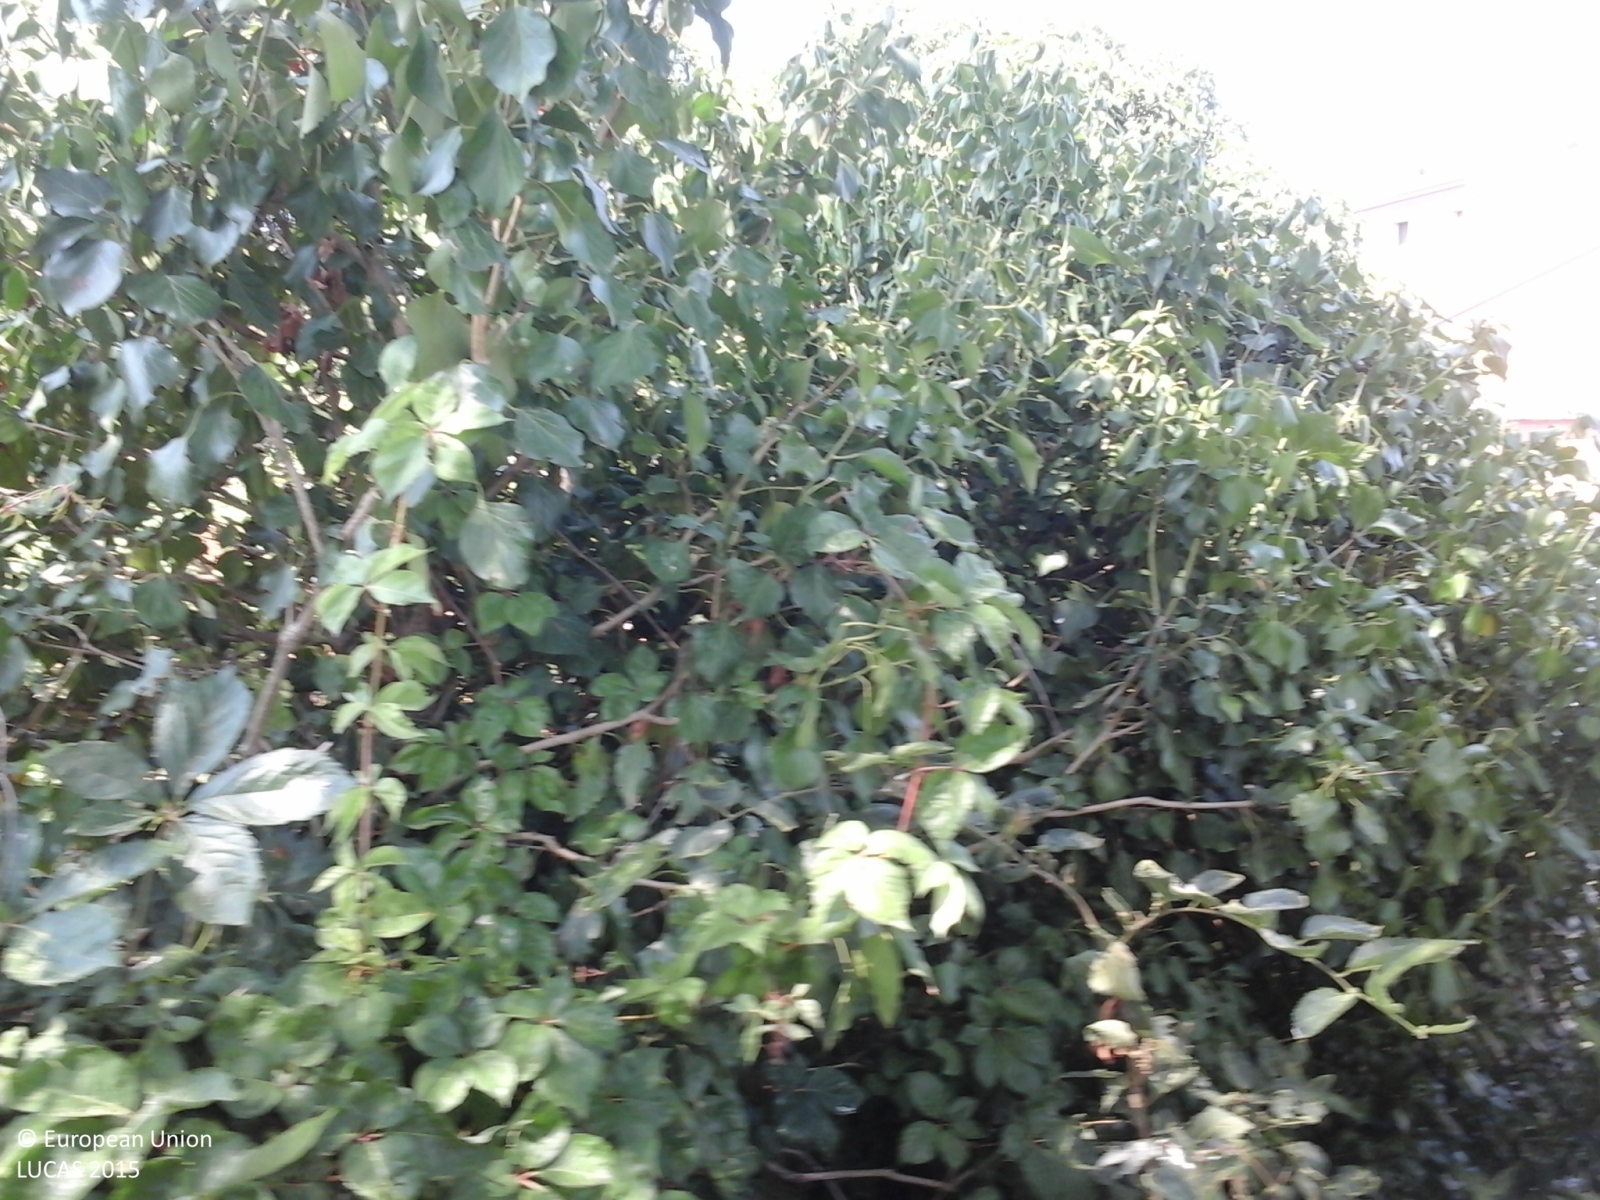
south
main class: Cropland
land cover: Vineyards
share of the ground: > 75 %
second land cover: Grassland without tree/shrub cover
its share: > 75 %
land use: Agriculture (excluding fallow land and kitchen gardens)
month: July
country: IT
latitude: 45.4813
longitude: 11.0345
